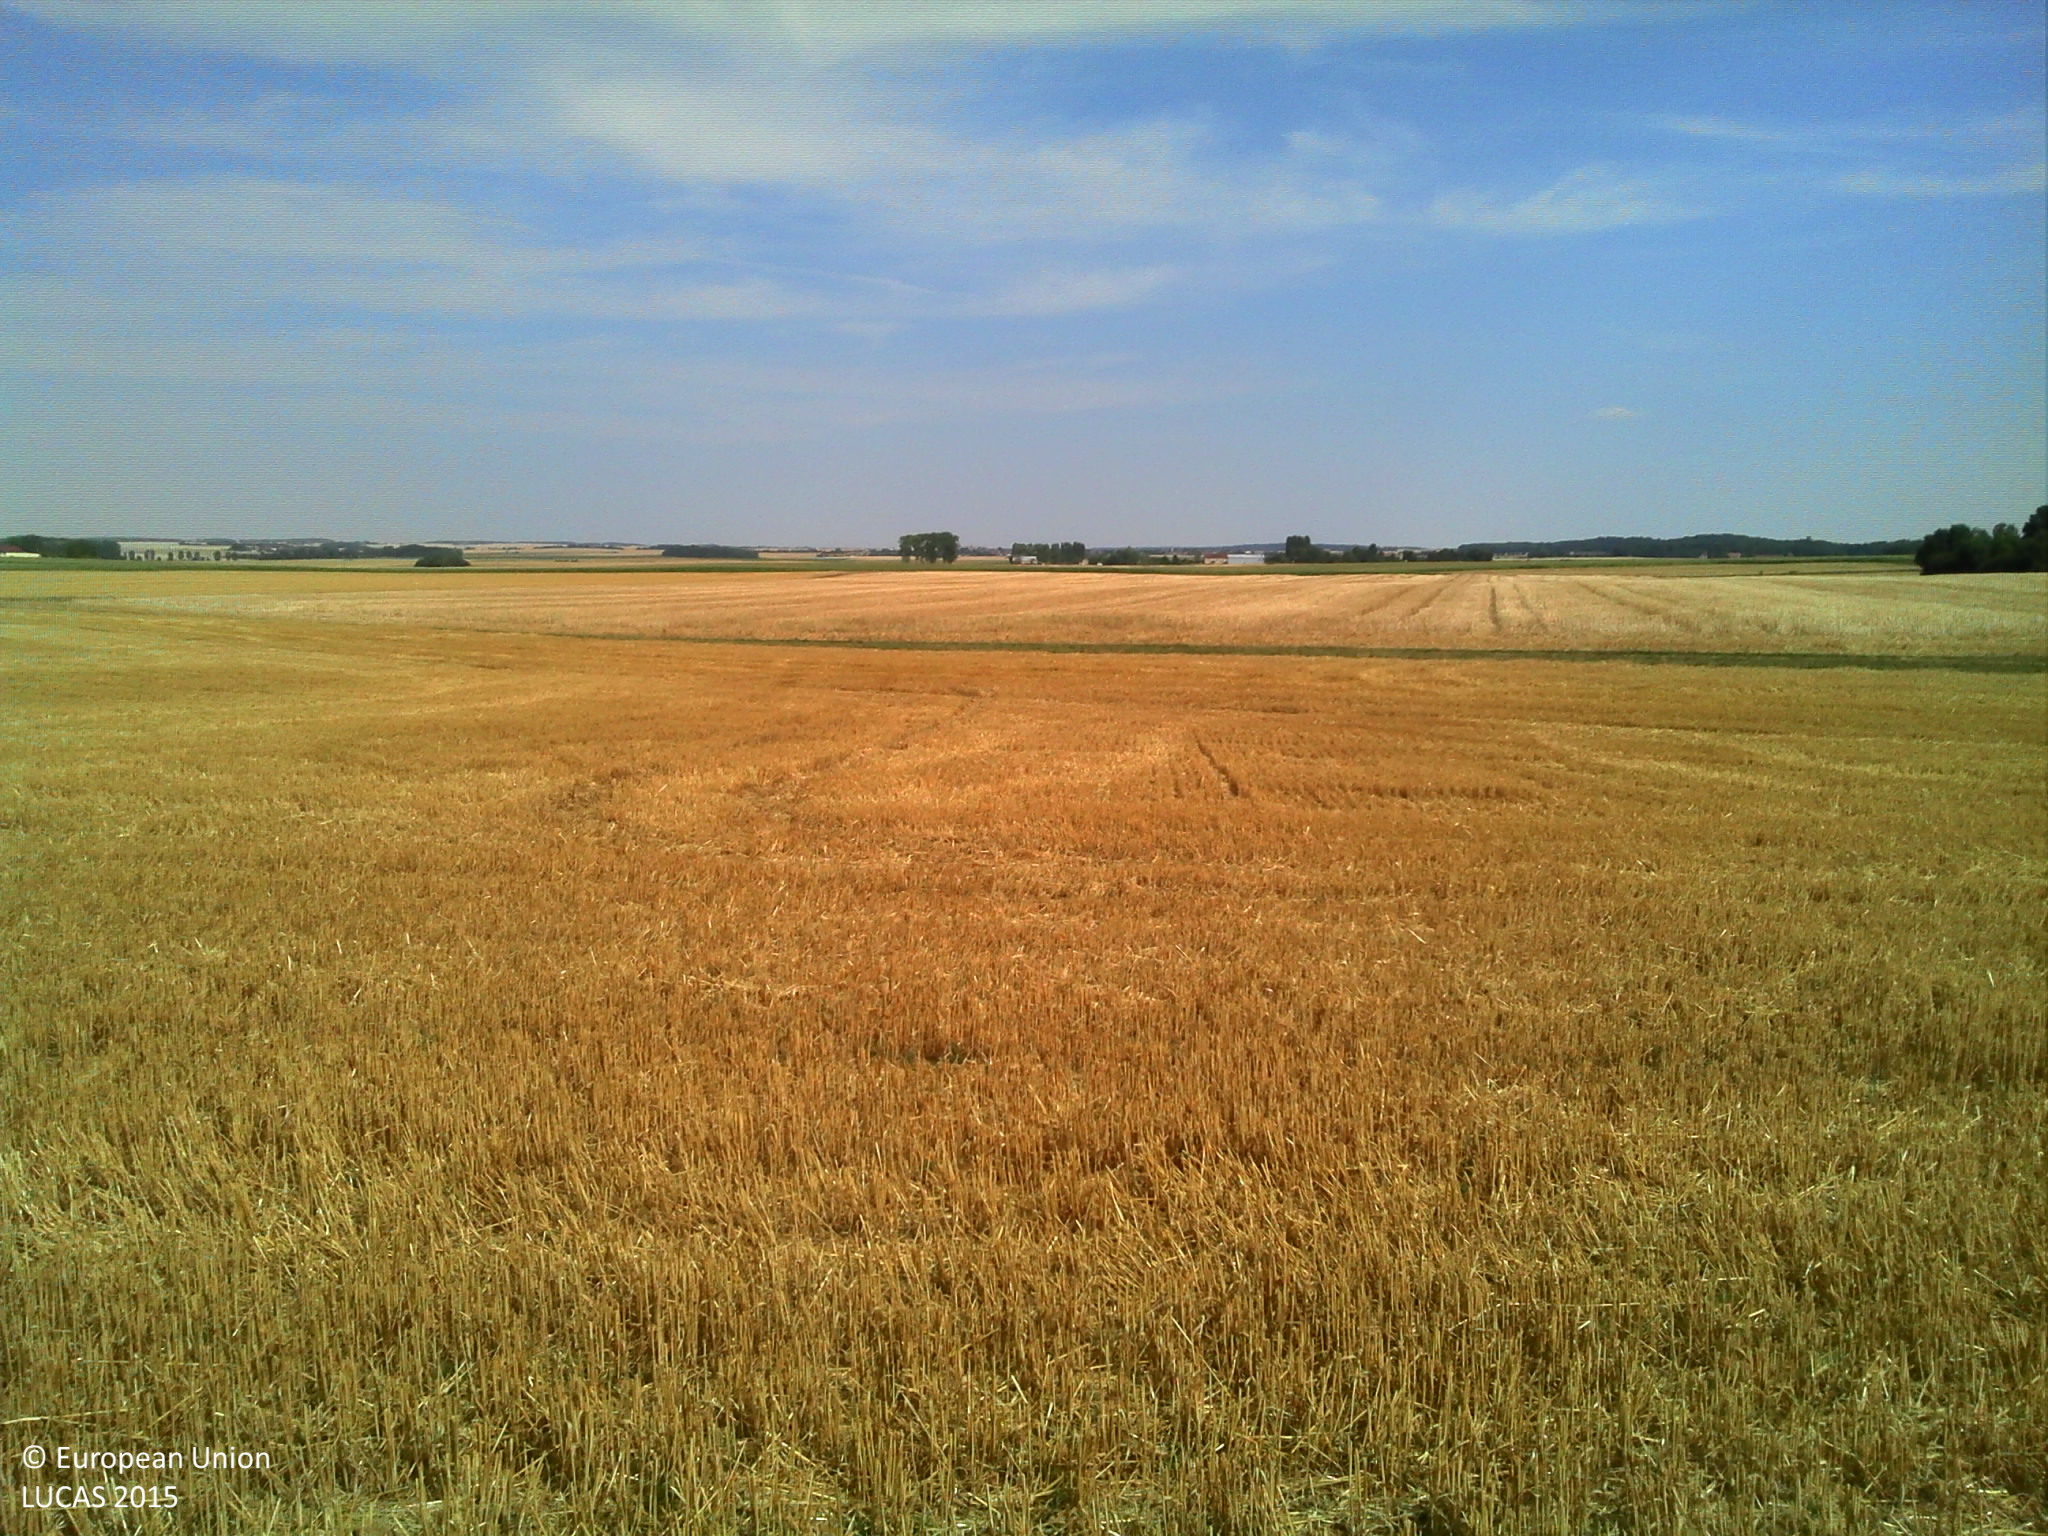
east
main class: Cropland
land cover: Maize
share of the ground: > 75 %
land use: Agriculture (excluding fallow land and kitchen gardens)
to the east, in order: Maize; Electric lines; Maize; Electric lines; Maize; Grass margins; Tracks; Grass margins; Common wheat; Tracks; Rape and turnip rape
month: August
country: FR
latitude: 48.6532
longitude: 3.3279
